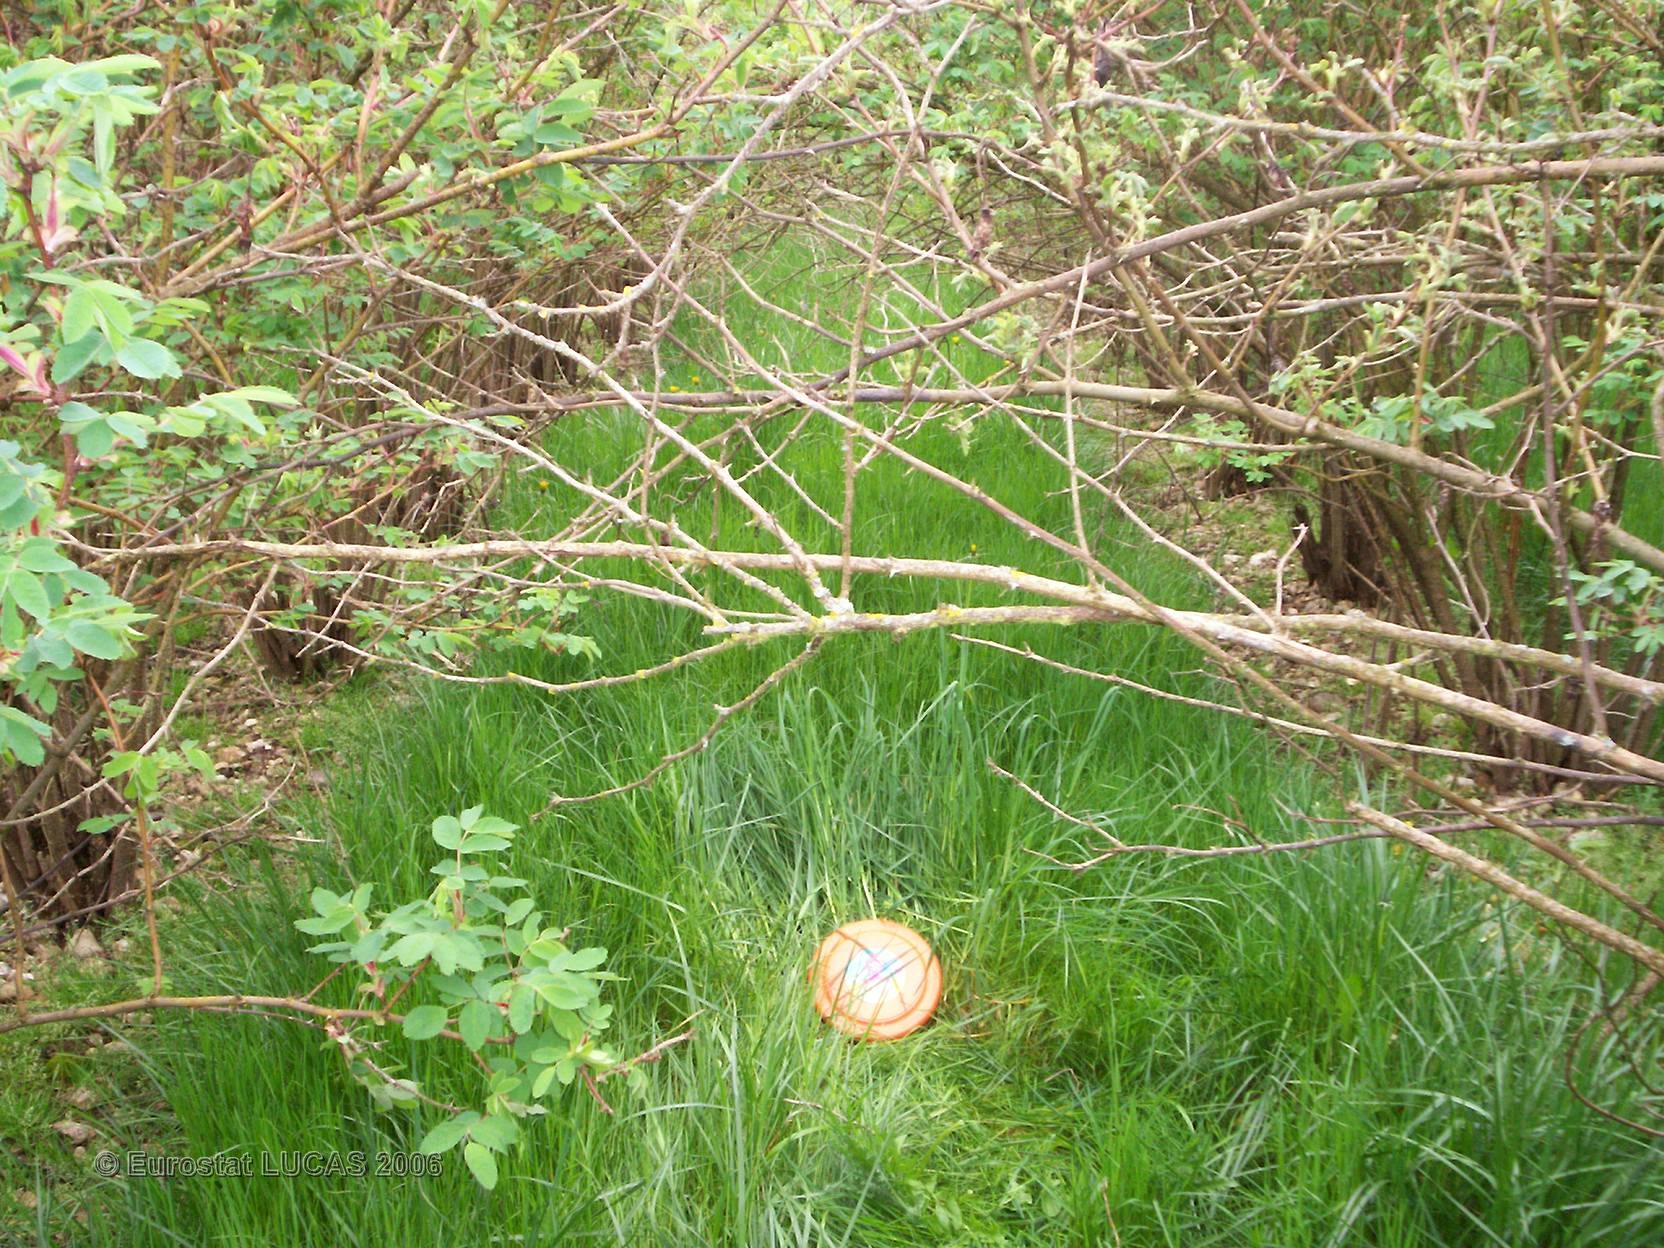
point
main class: Cropland
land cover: Other fruit trees and berries
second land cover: Grassland with sparse tree/shrub cover
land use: Agriculture (excluding fallow land and kitchen gardens)
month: April
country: FR
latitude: 48.0467
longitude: 2.8690
